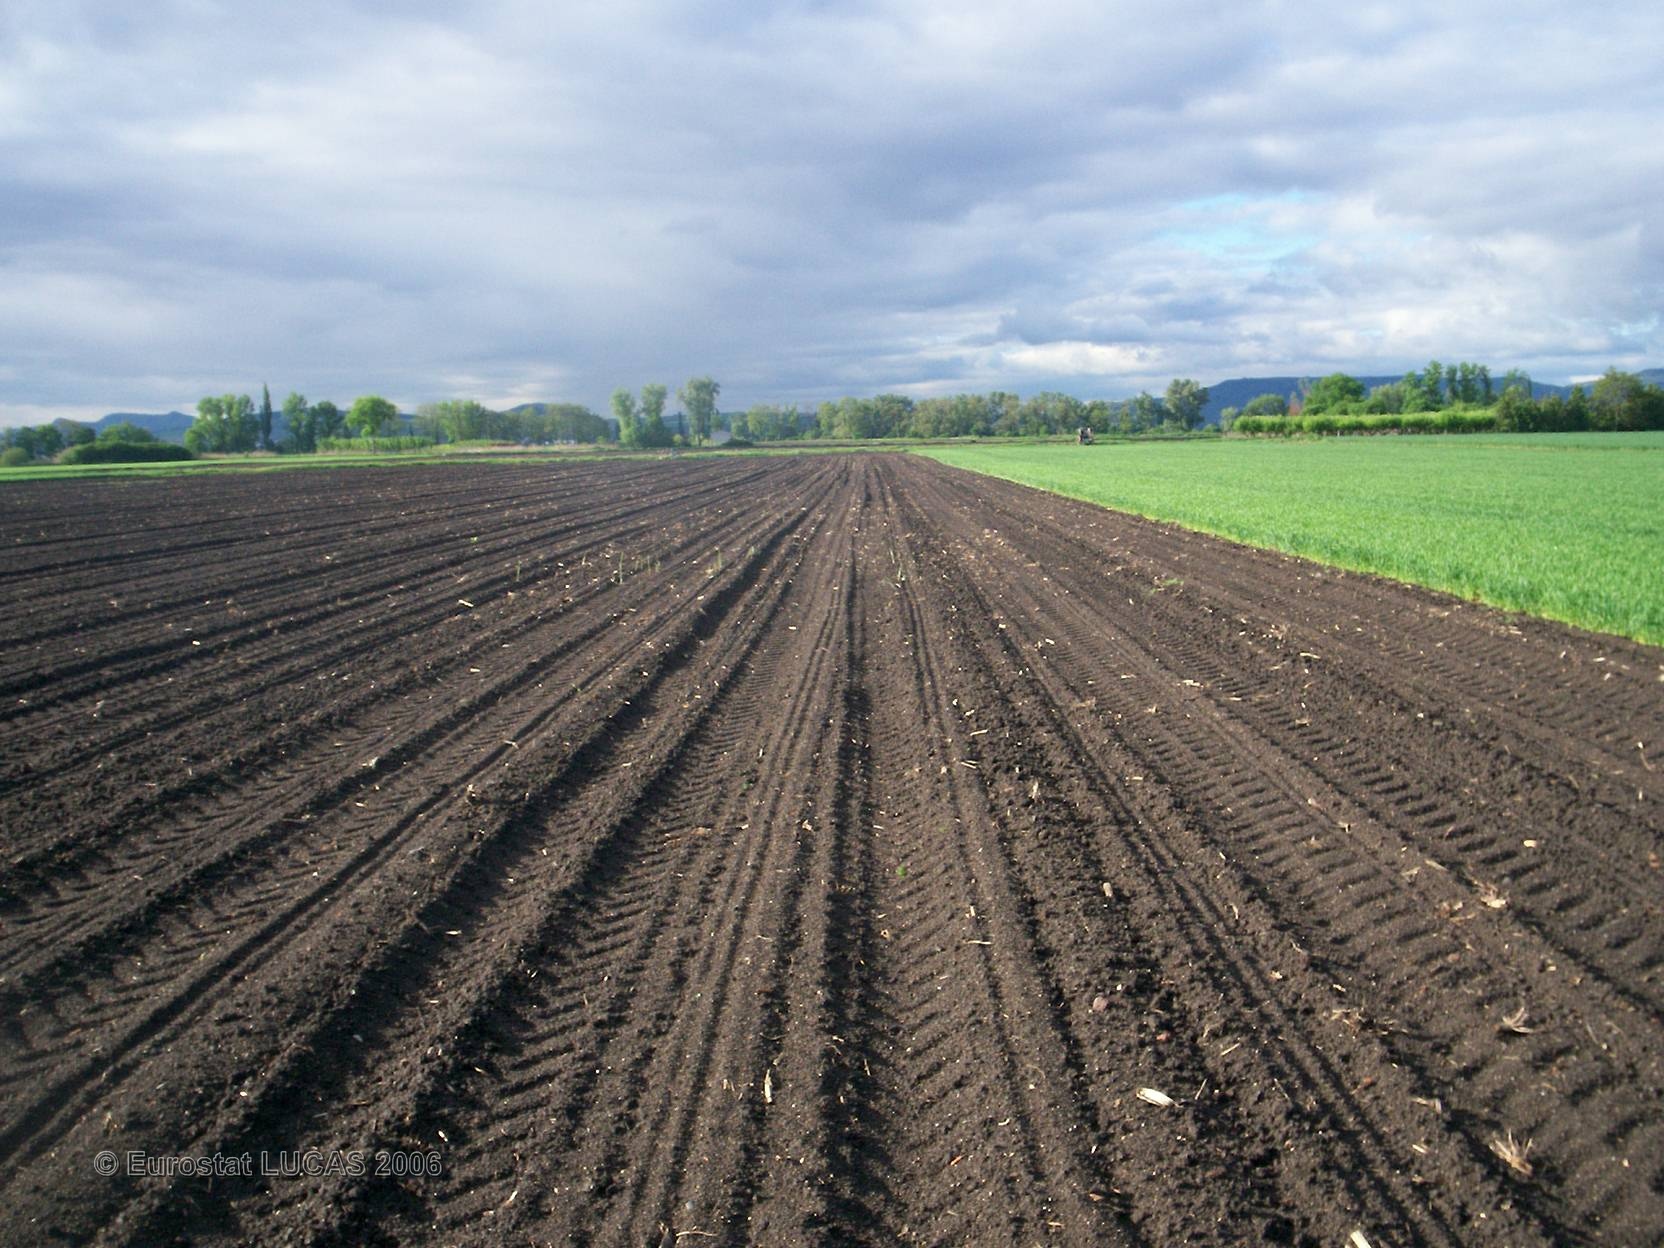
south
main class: Cropland
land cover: Maize
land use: Agriculture (excluding fallow land and kitchen gardens)
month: May
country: FR
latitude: 45.8252
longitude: 3.1648
